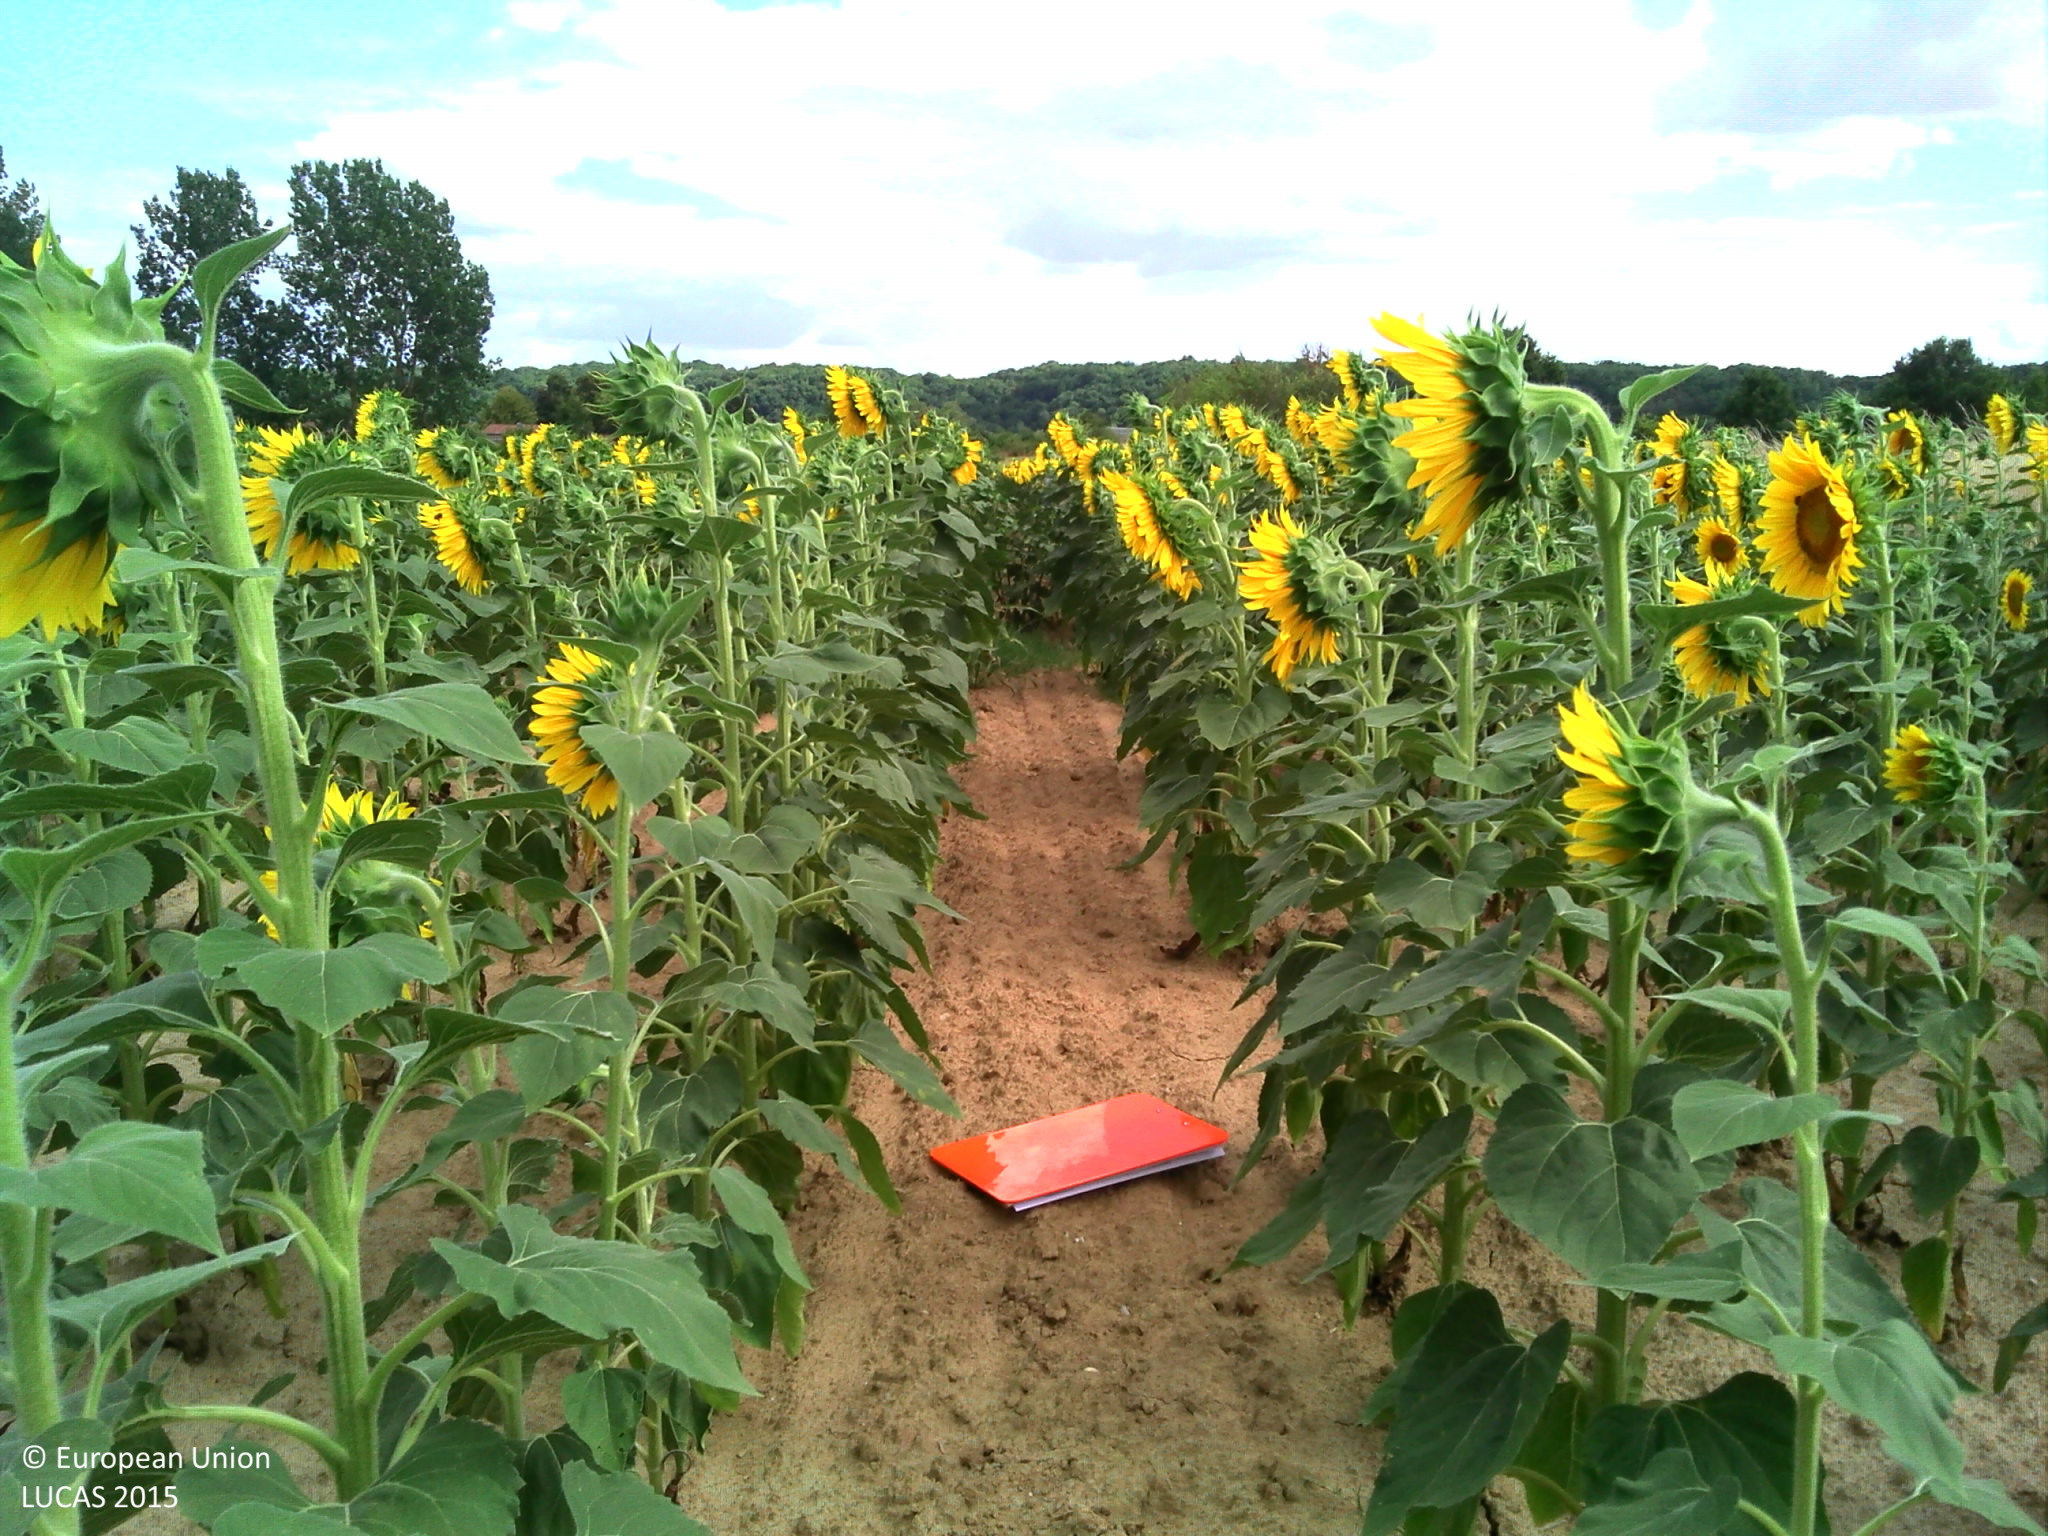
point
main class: Cropland
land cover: Sunflower
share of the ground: 50 - 75 %
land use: Agriculture (excluding fallow land and kitchen gardens)
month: July
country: FR
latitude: 44.4543
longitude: 0.6561
